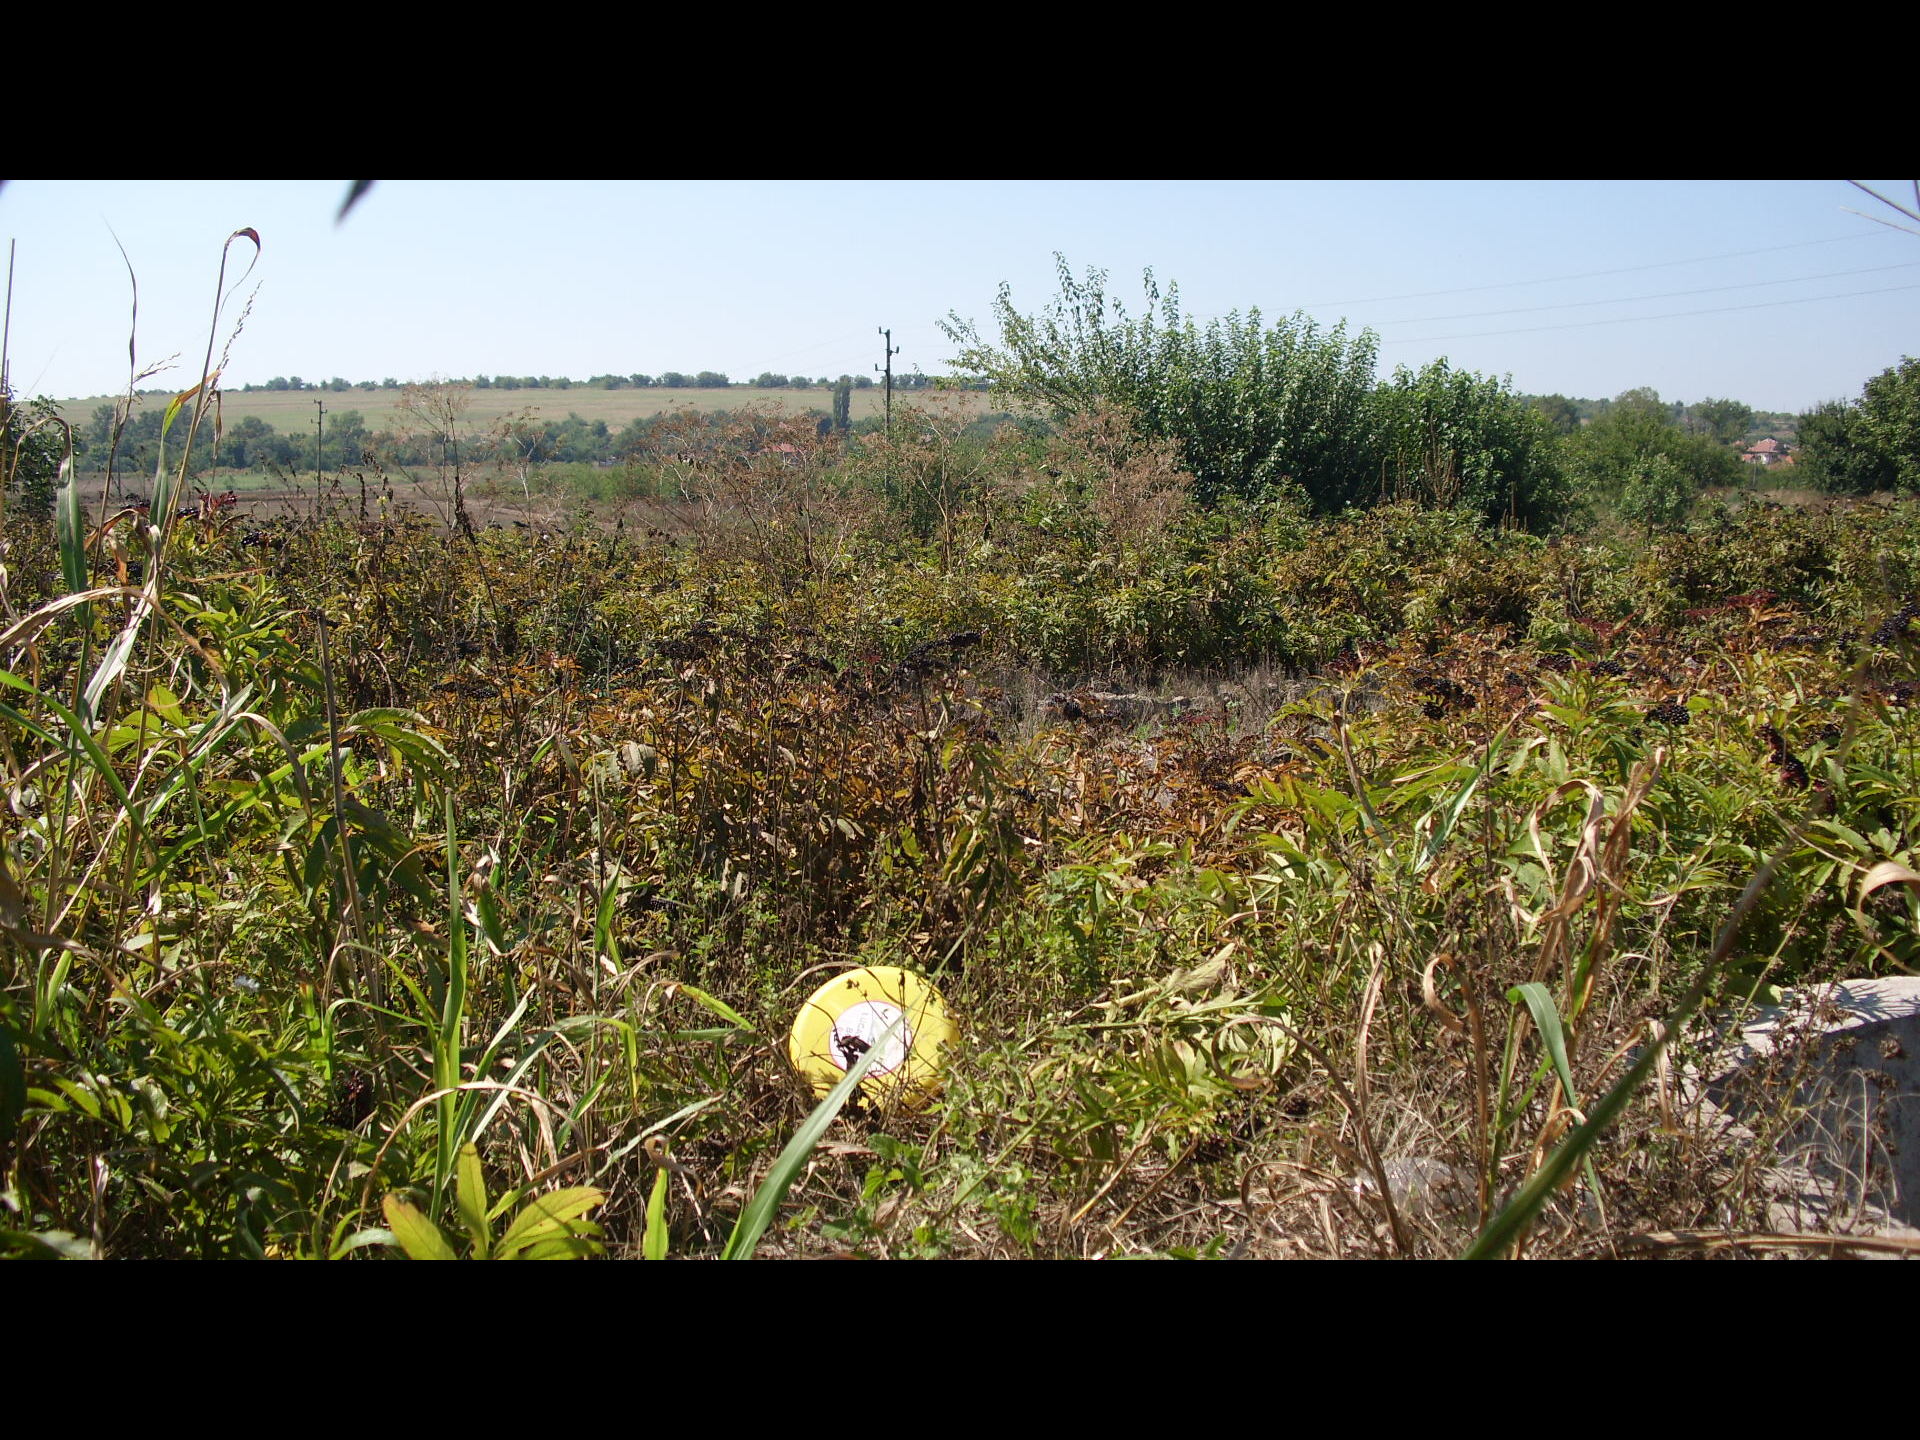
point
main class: Grassland
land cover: Grassland with sparse tree/shrub cover
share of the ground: > 75 %
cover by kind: herbaceous plants 85 %, shrubs 10 %, broadleaved forest trees 5 %
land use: Abandoned areas
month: August
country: BG
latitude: 44.0930
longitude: 22.8679
